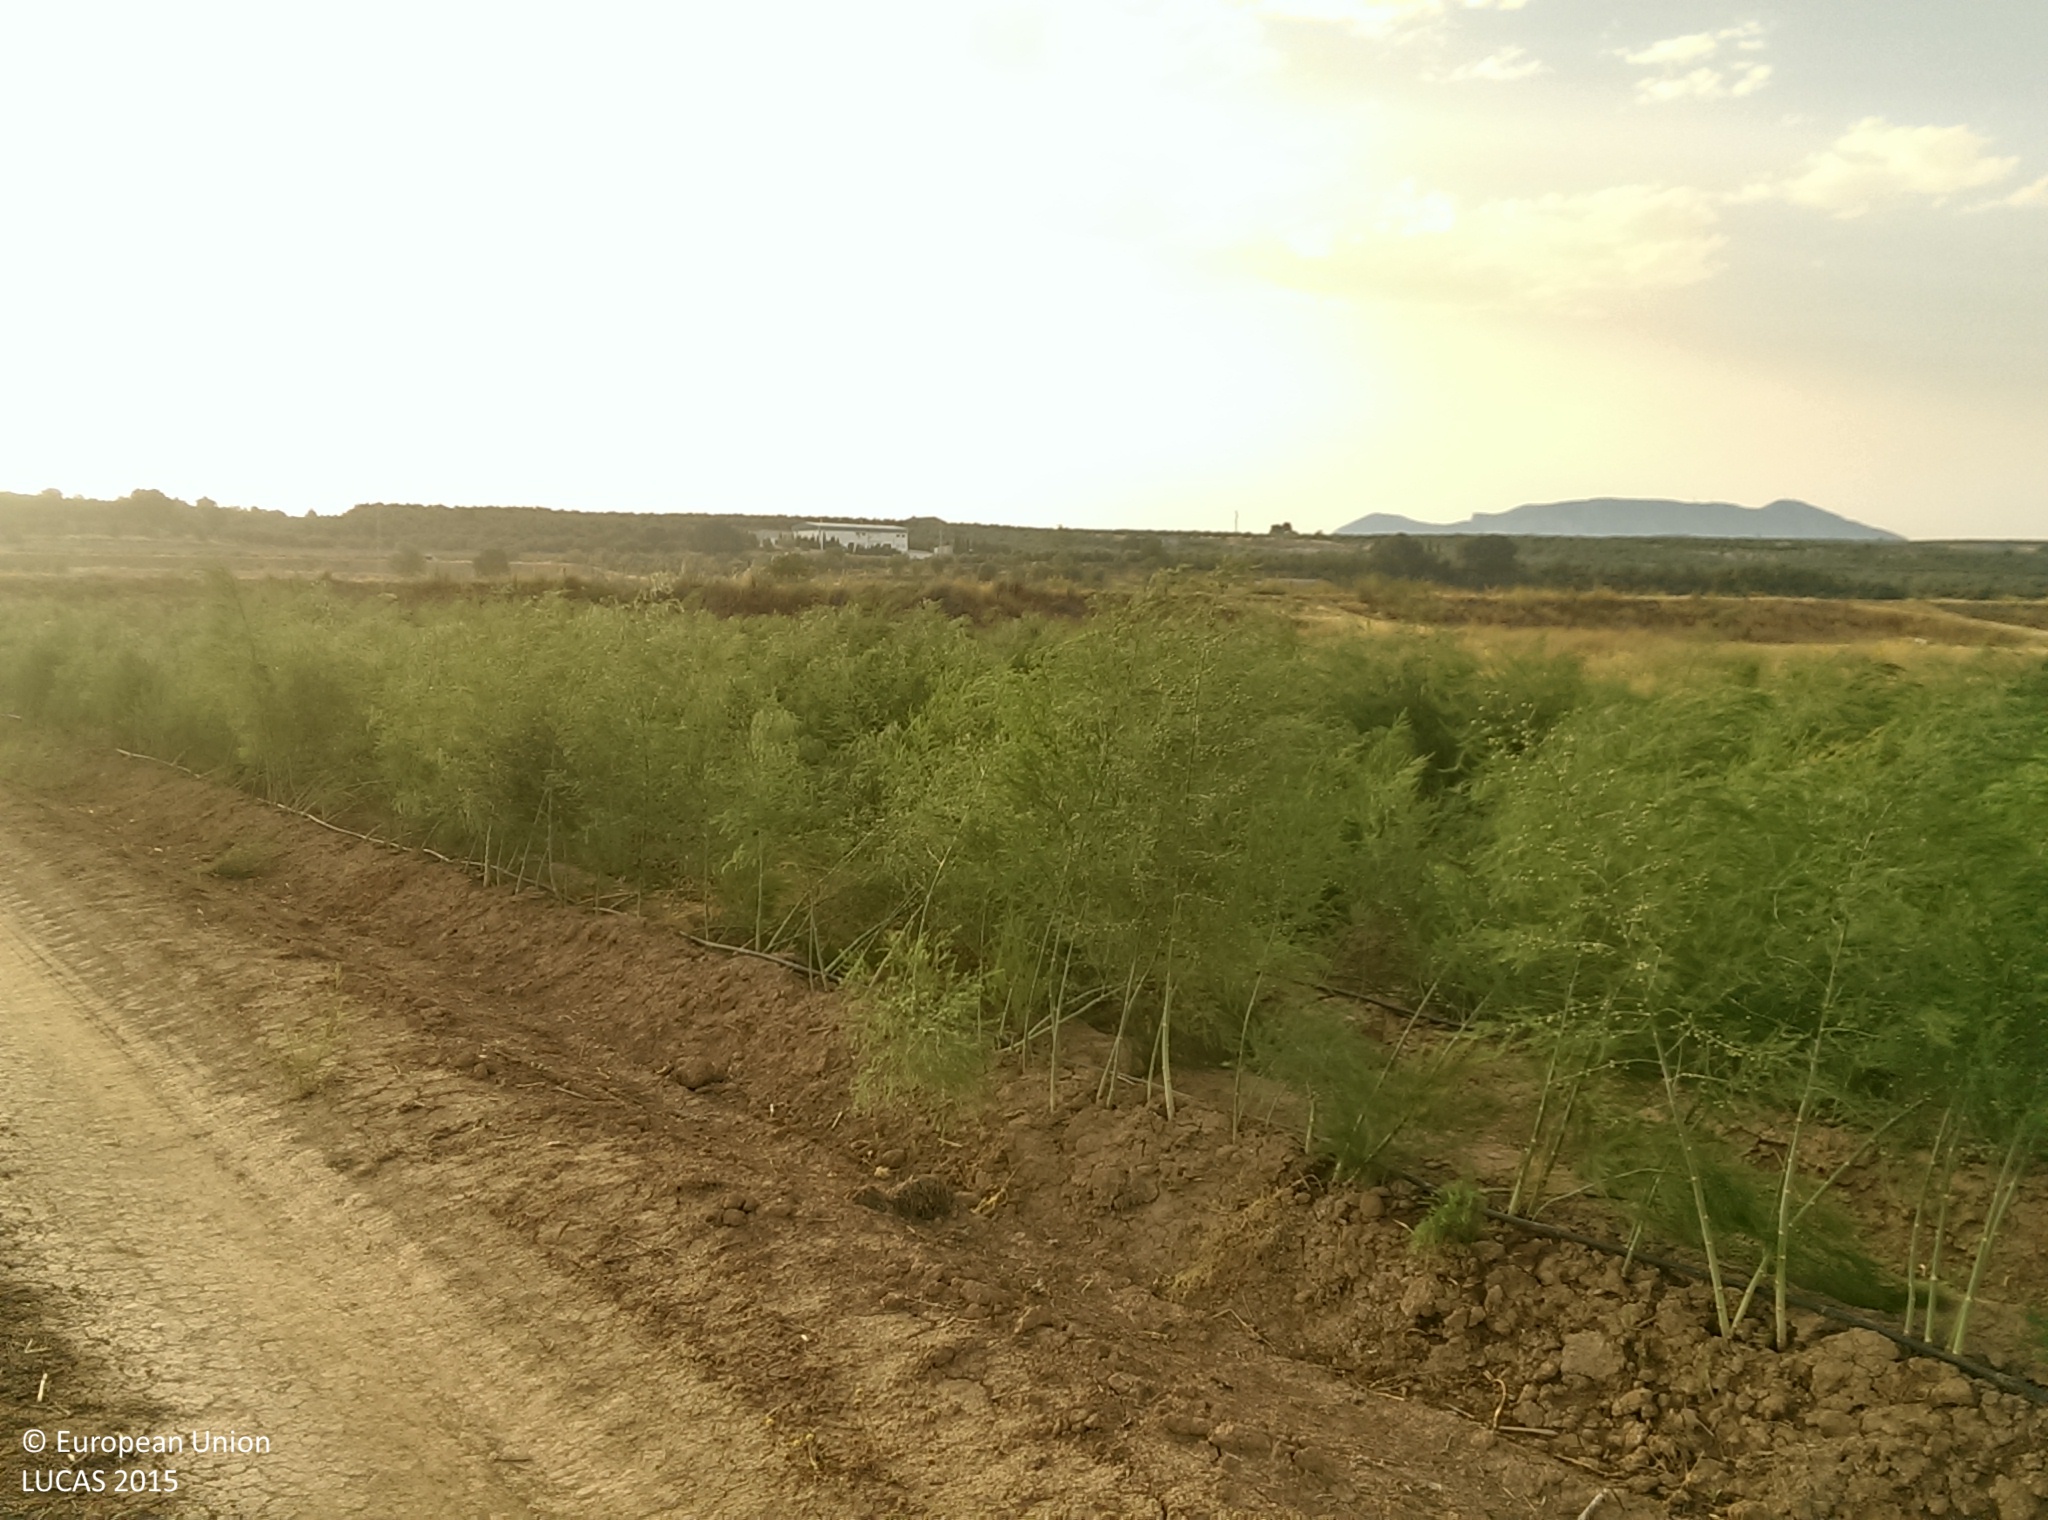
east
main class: Cropland
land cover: Other fresh vegetables
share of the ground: > 75 %
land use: Agriculture (excluding fallow land and kitchen gardens)
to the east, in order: Tracks; Other fresh vegetables; Grass margins; Barley; Spontaneously vegetated surfaces; Grass margins; Paved roads, cycling and walking lanes; Grassland without tree/shrub cover; Ditches and canals; Tracks; Grass margins; Spontaneously vegetated surfaces; Grass margins; Common wheat; Grass margins; Other bare soil; Ditches and canals; Grass margins; Common wheat
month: July
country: ES
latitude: 37.6294
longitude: -2.9419
